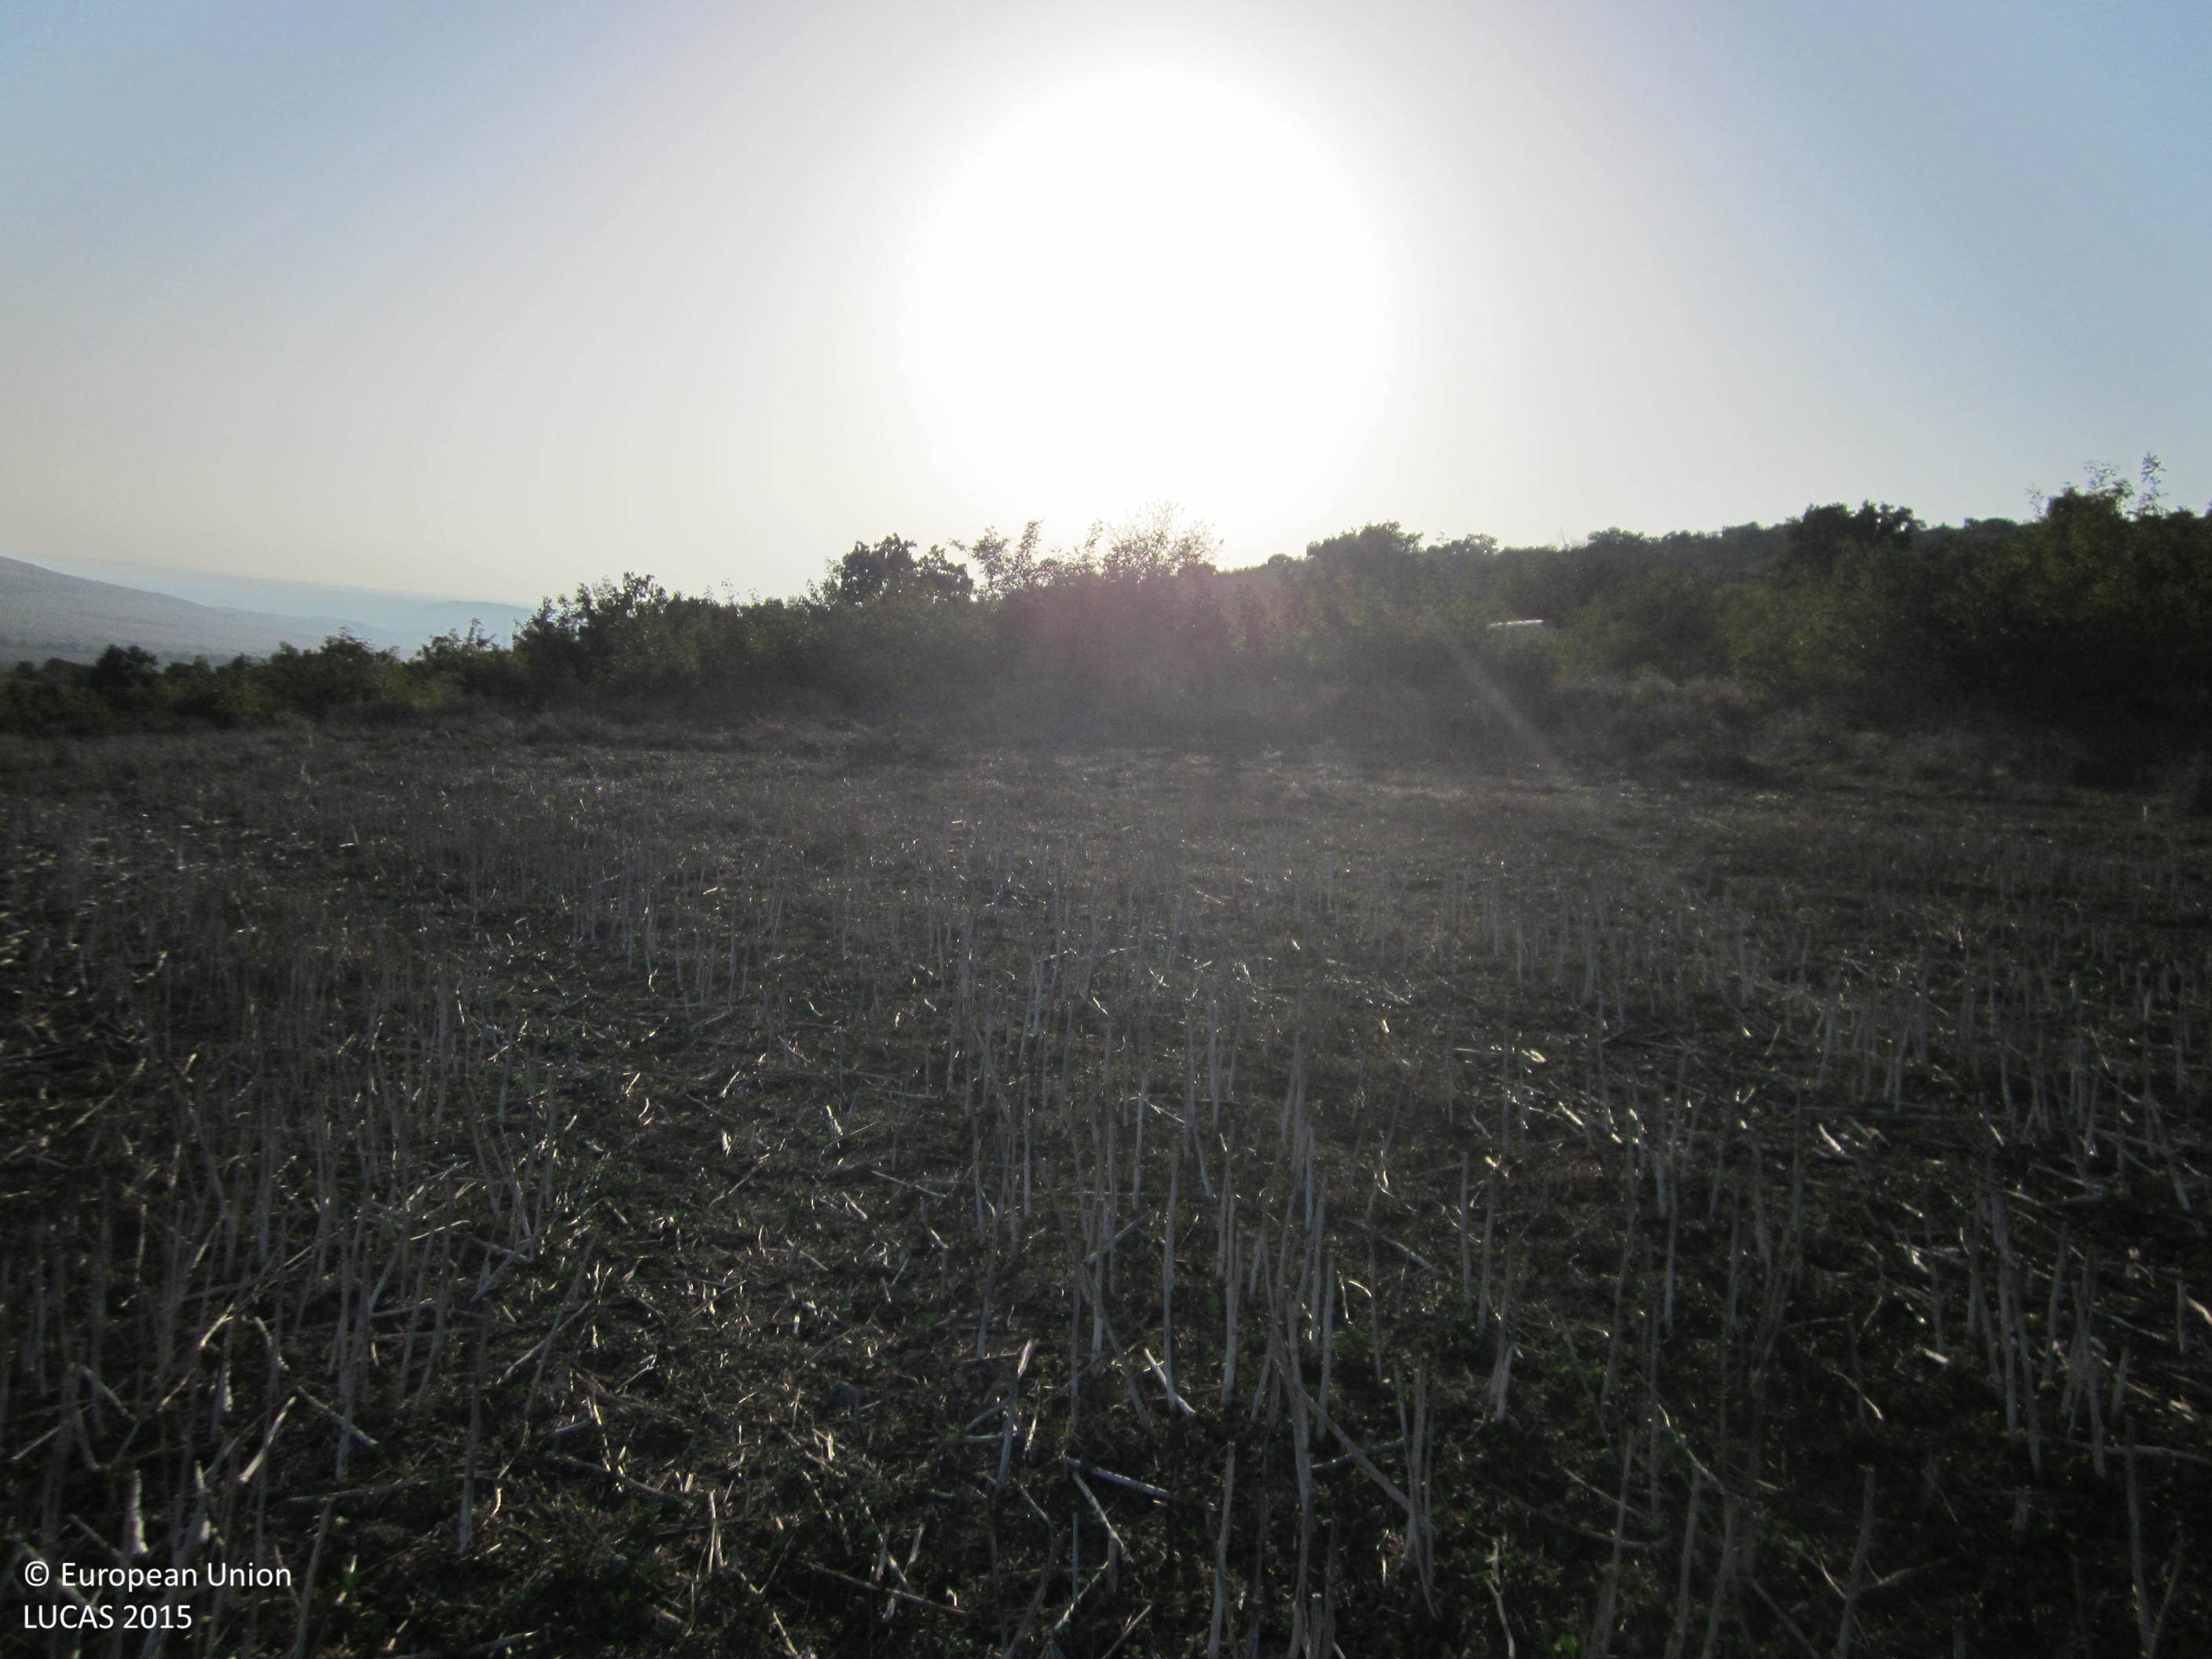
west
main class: Cropland
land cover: Rape and turnip rape
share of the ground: 10 - 25 %
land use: Agriculture (excluding fallow land and kitchen gardens)
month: September
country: BG
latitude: 42.6538
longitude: 27.3524
